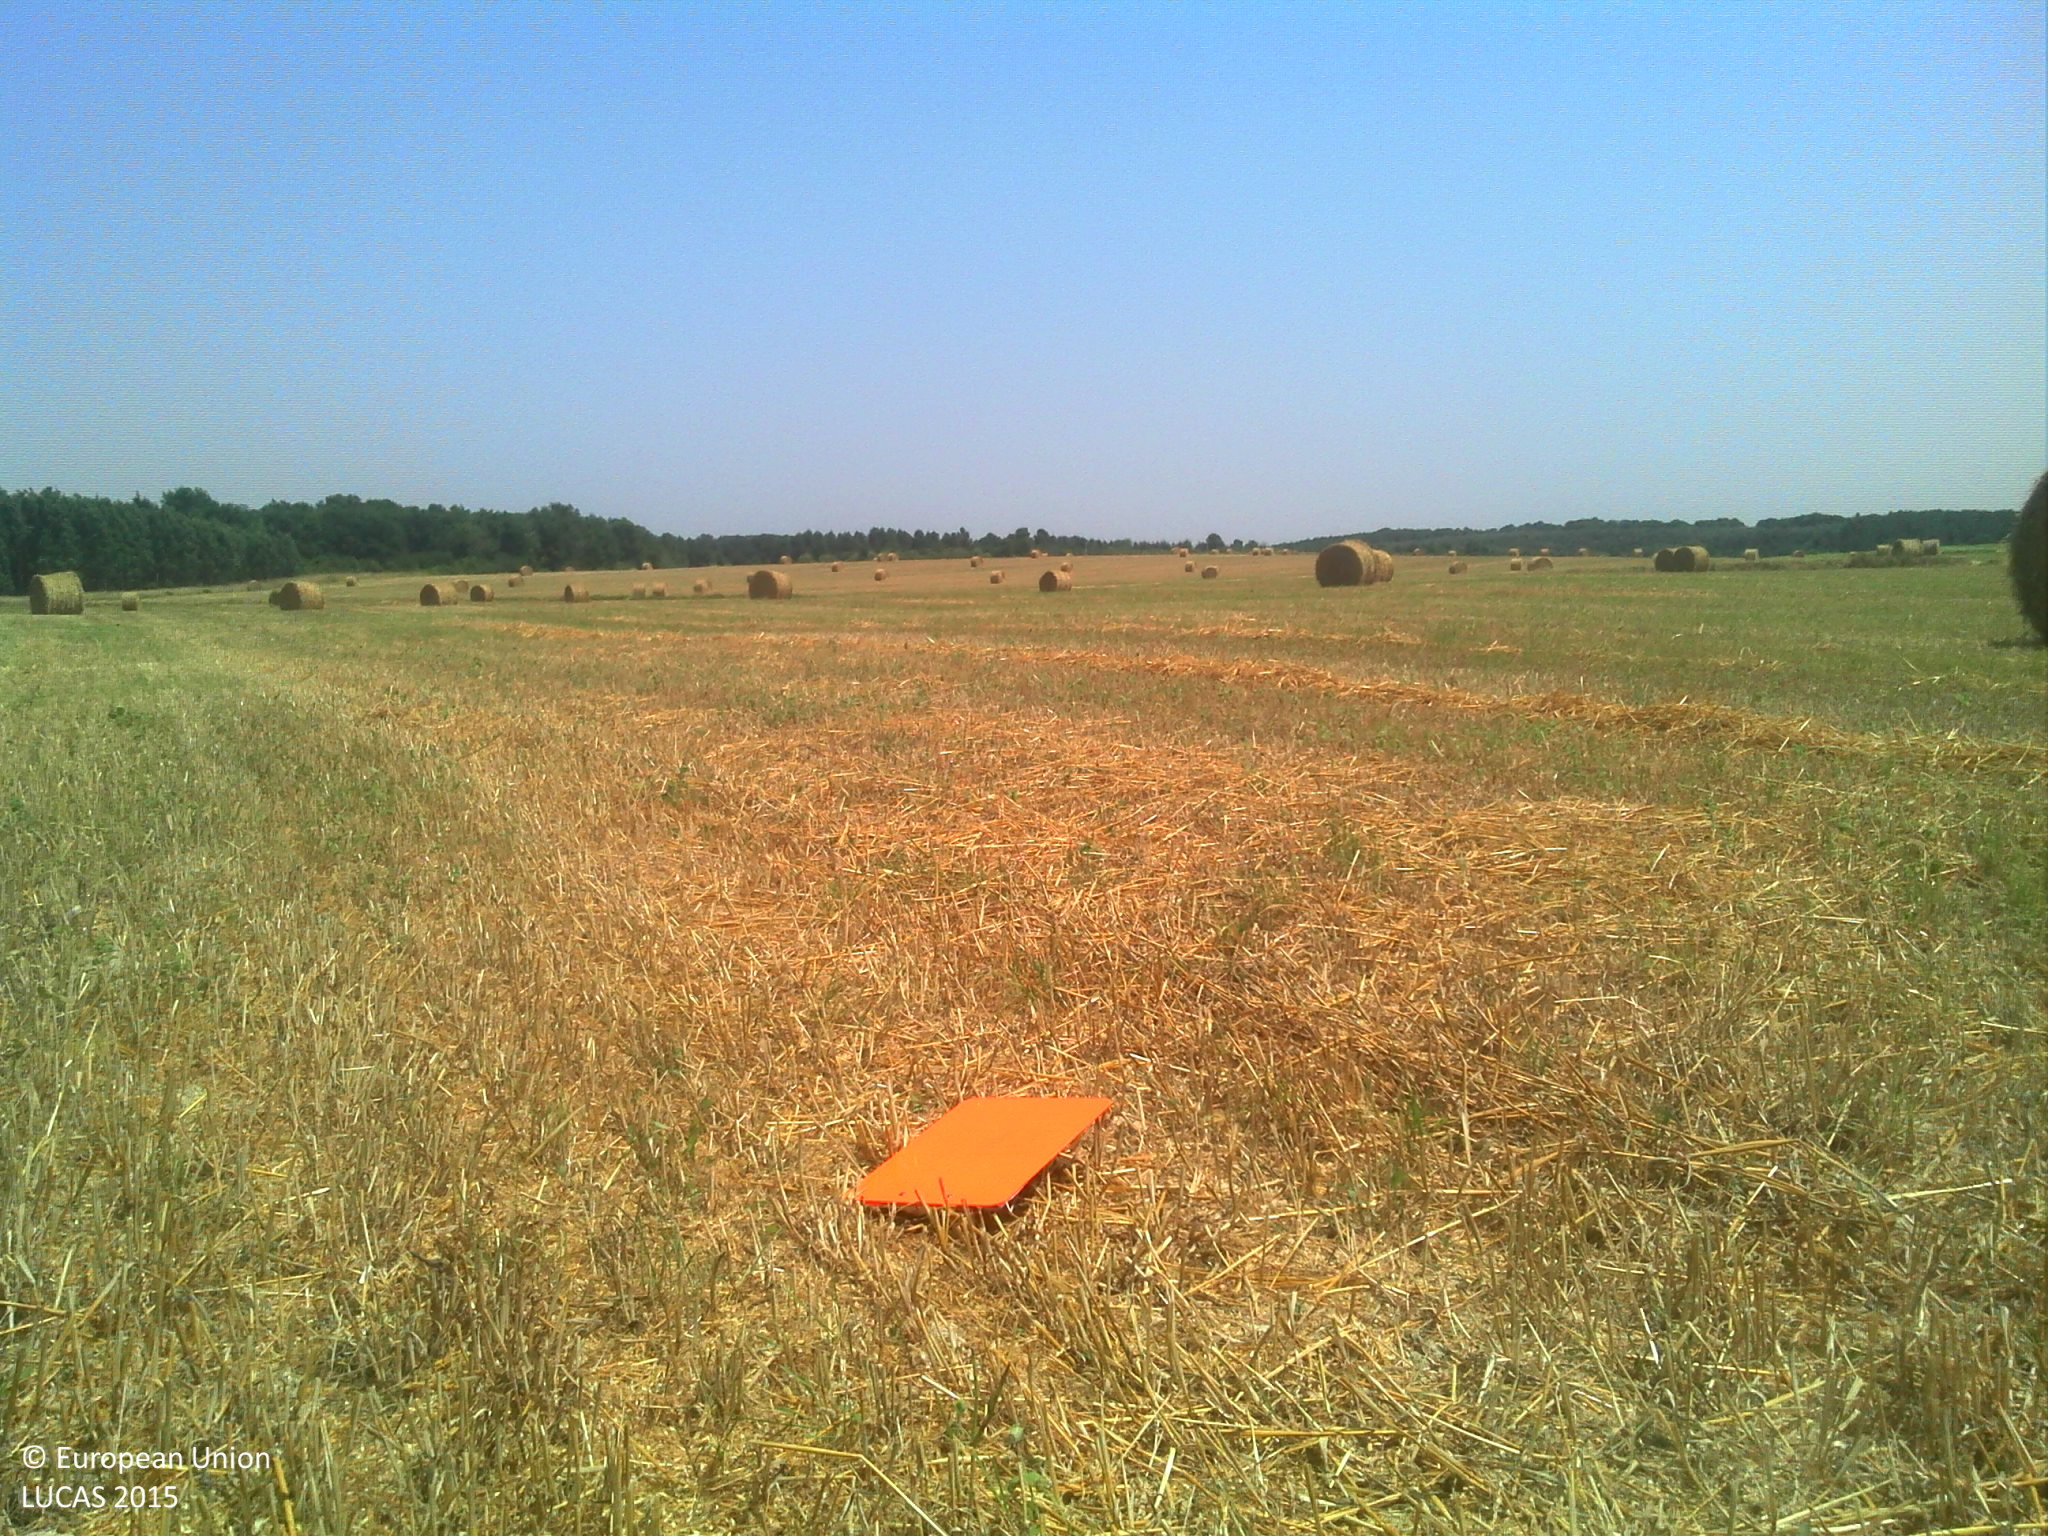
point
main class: Cropland
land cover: Barley
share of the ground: > 75 %
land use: Agriculture (excluding fallow land and kitchen gardens)
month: July
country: FR
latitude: 43.3871
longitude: 1.1018
